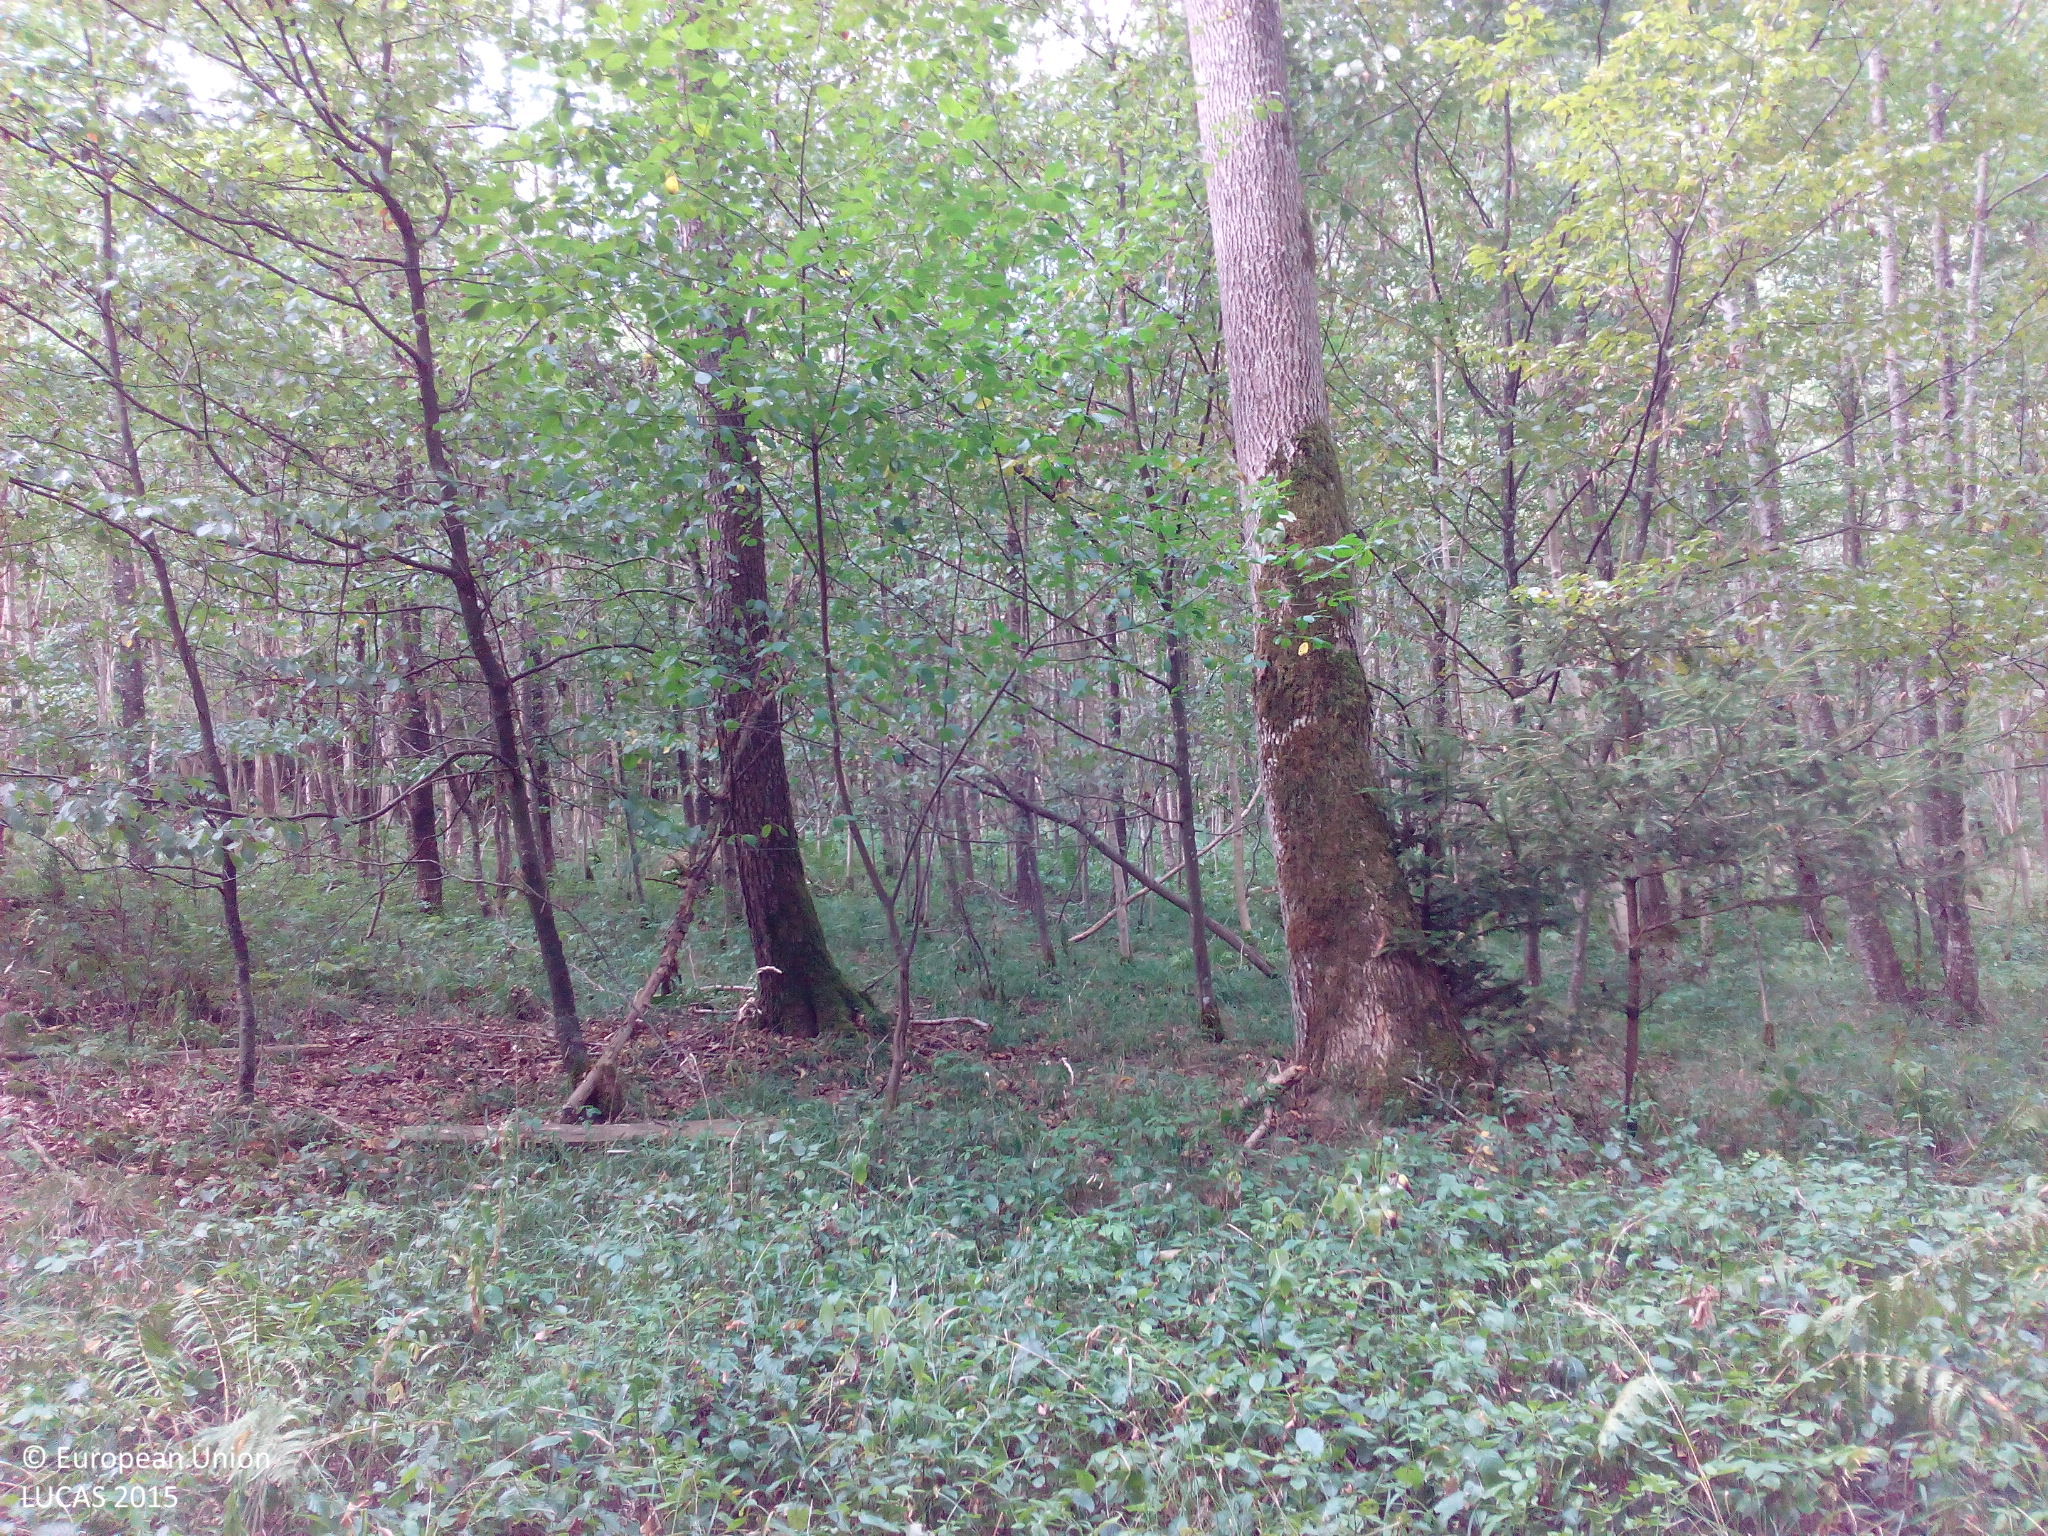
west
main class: Woodland
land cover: Broadleaved woodland
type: mesophytic deciduous forest
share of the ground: > 75 %
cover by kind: broadleaved forest trees 80 %, coniferous forest trees 10 %, unconsolidated bare surface 10 %
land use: Forestry
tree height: > 5 m
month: September
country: DE
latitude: 48.6721
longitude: 10.5293
